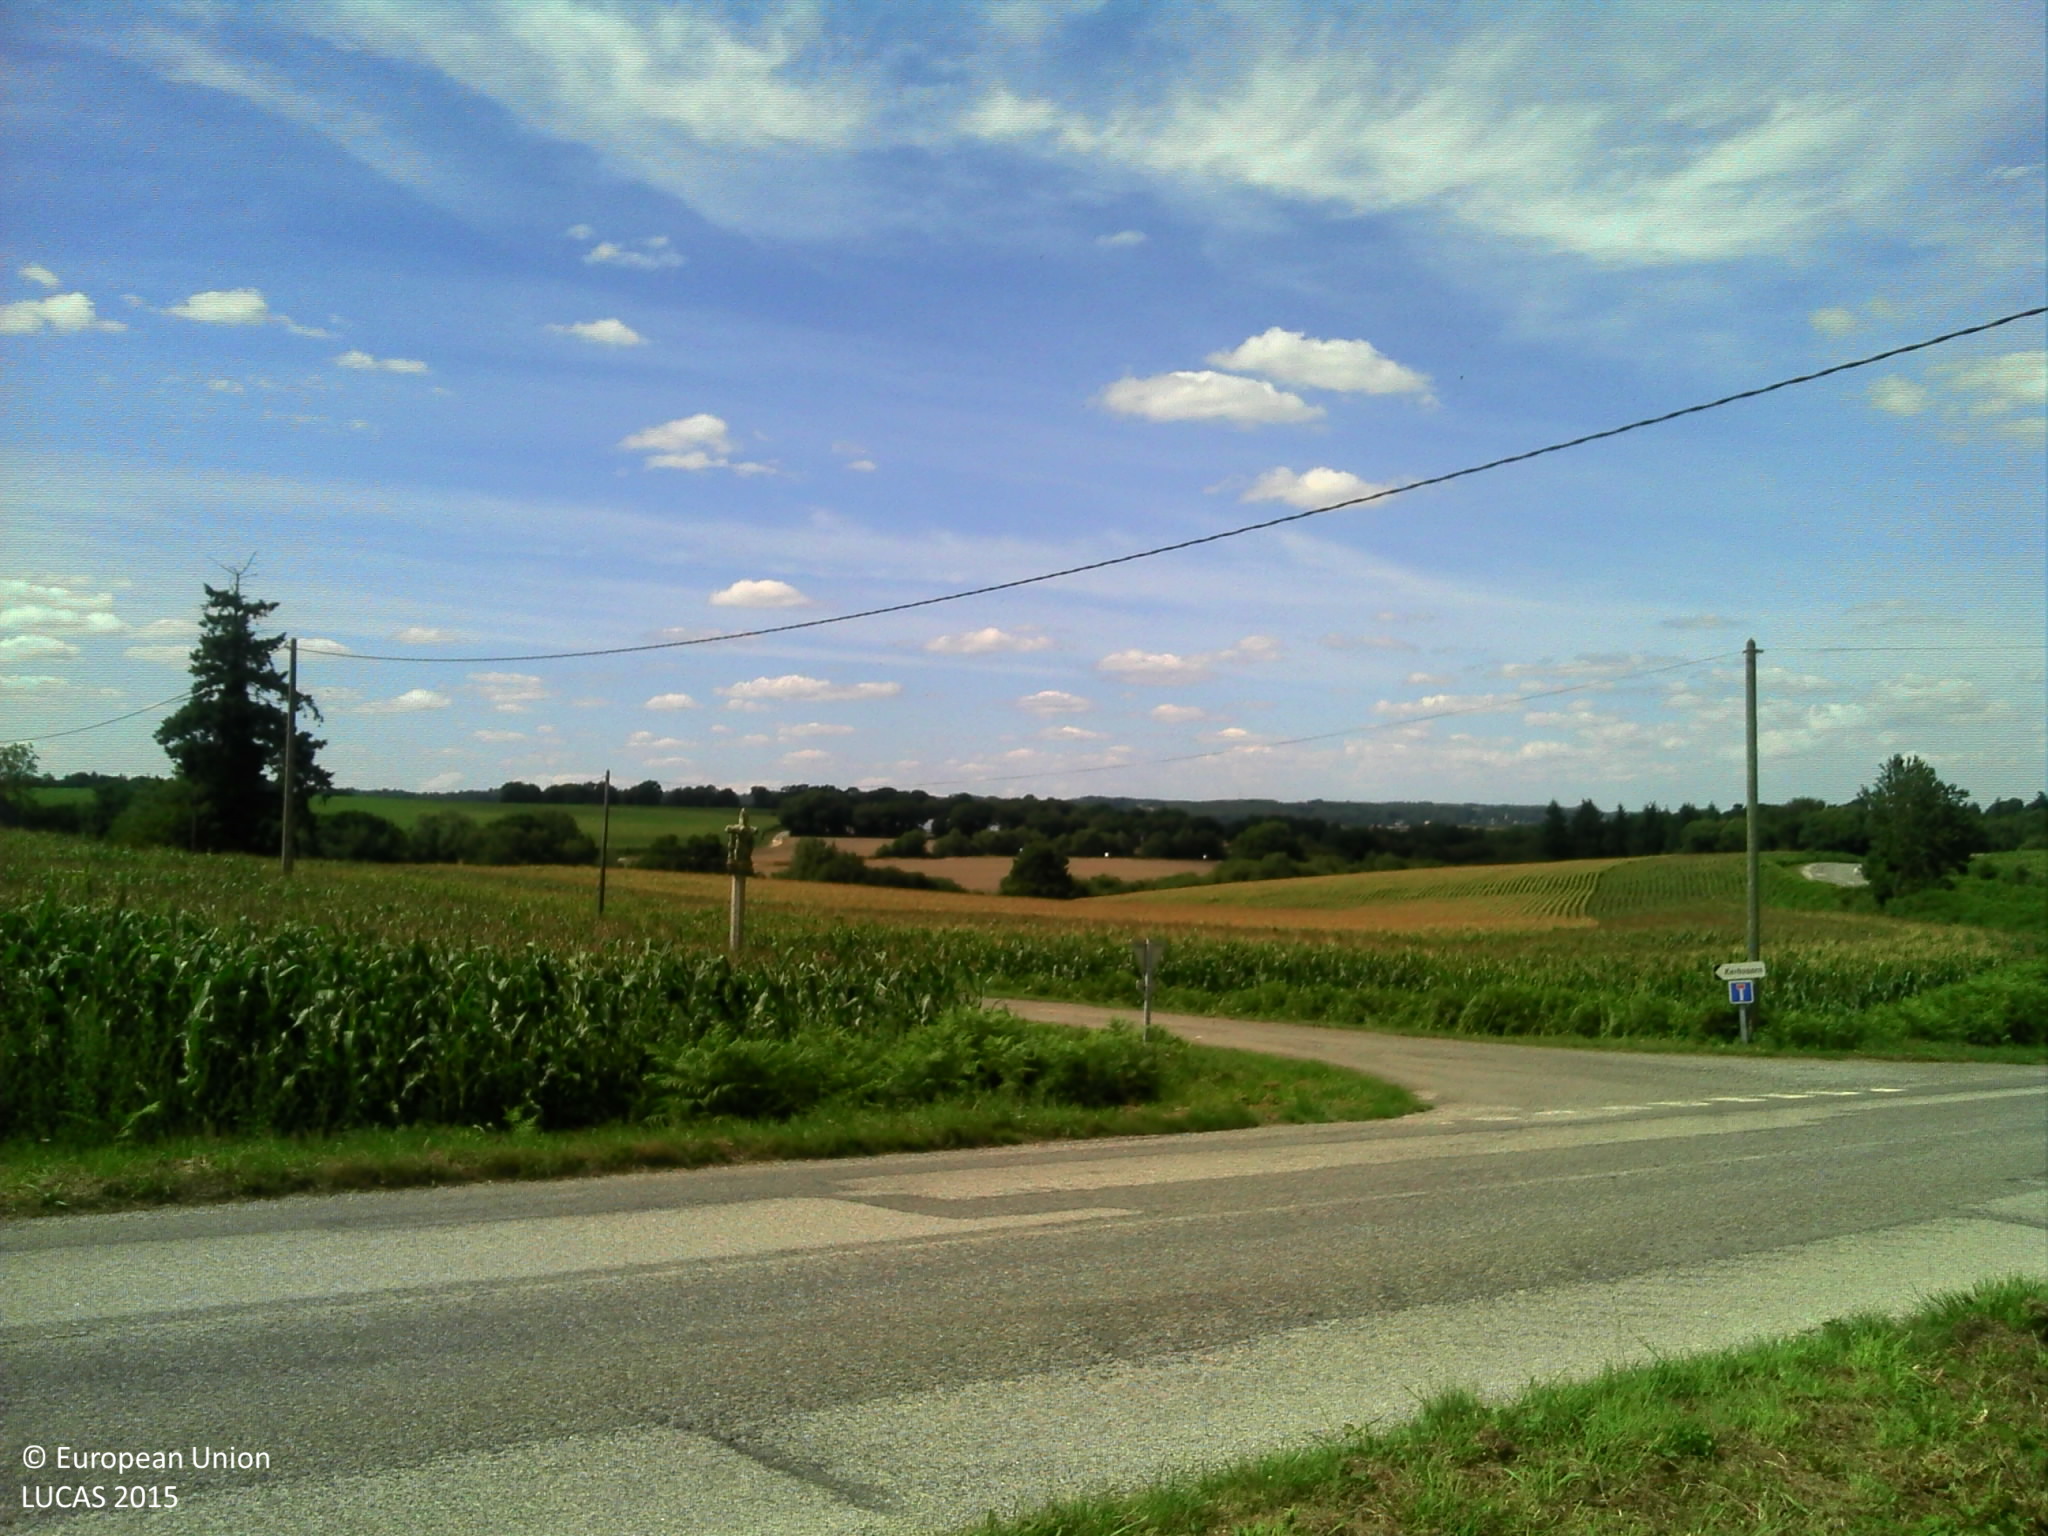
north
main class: Cropland
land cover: Maize
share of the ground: > 75 %
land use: Agriculture (excluding fallow land and kitchen gardens)
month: July
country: FR
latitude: 47.9996
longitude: -2.9739
